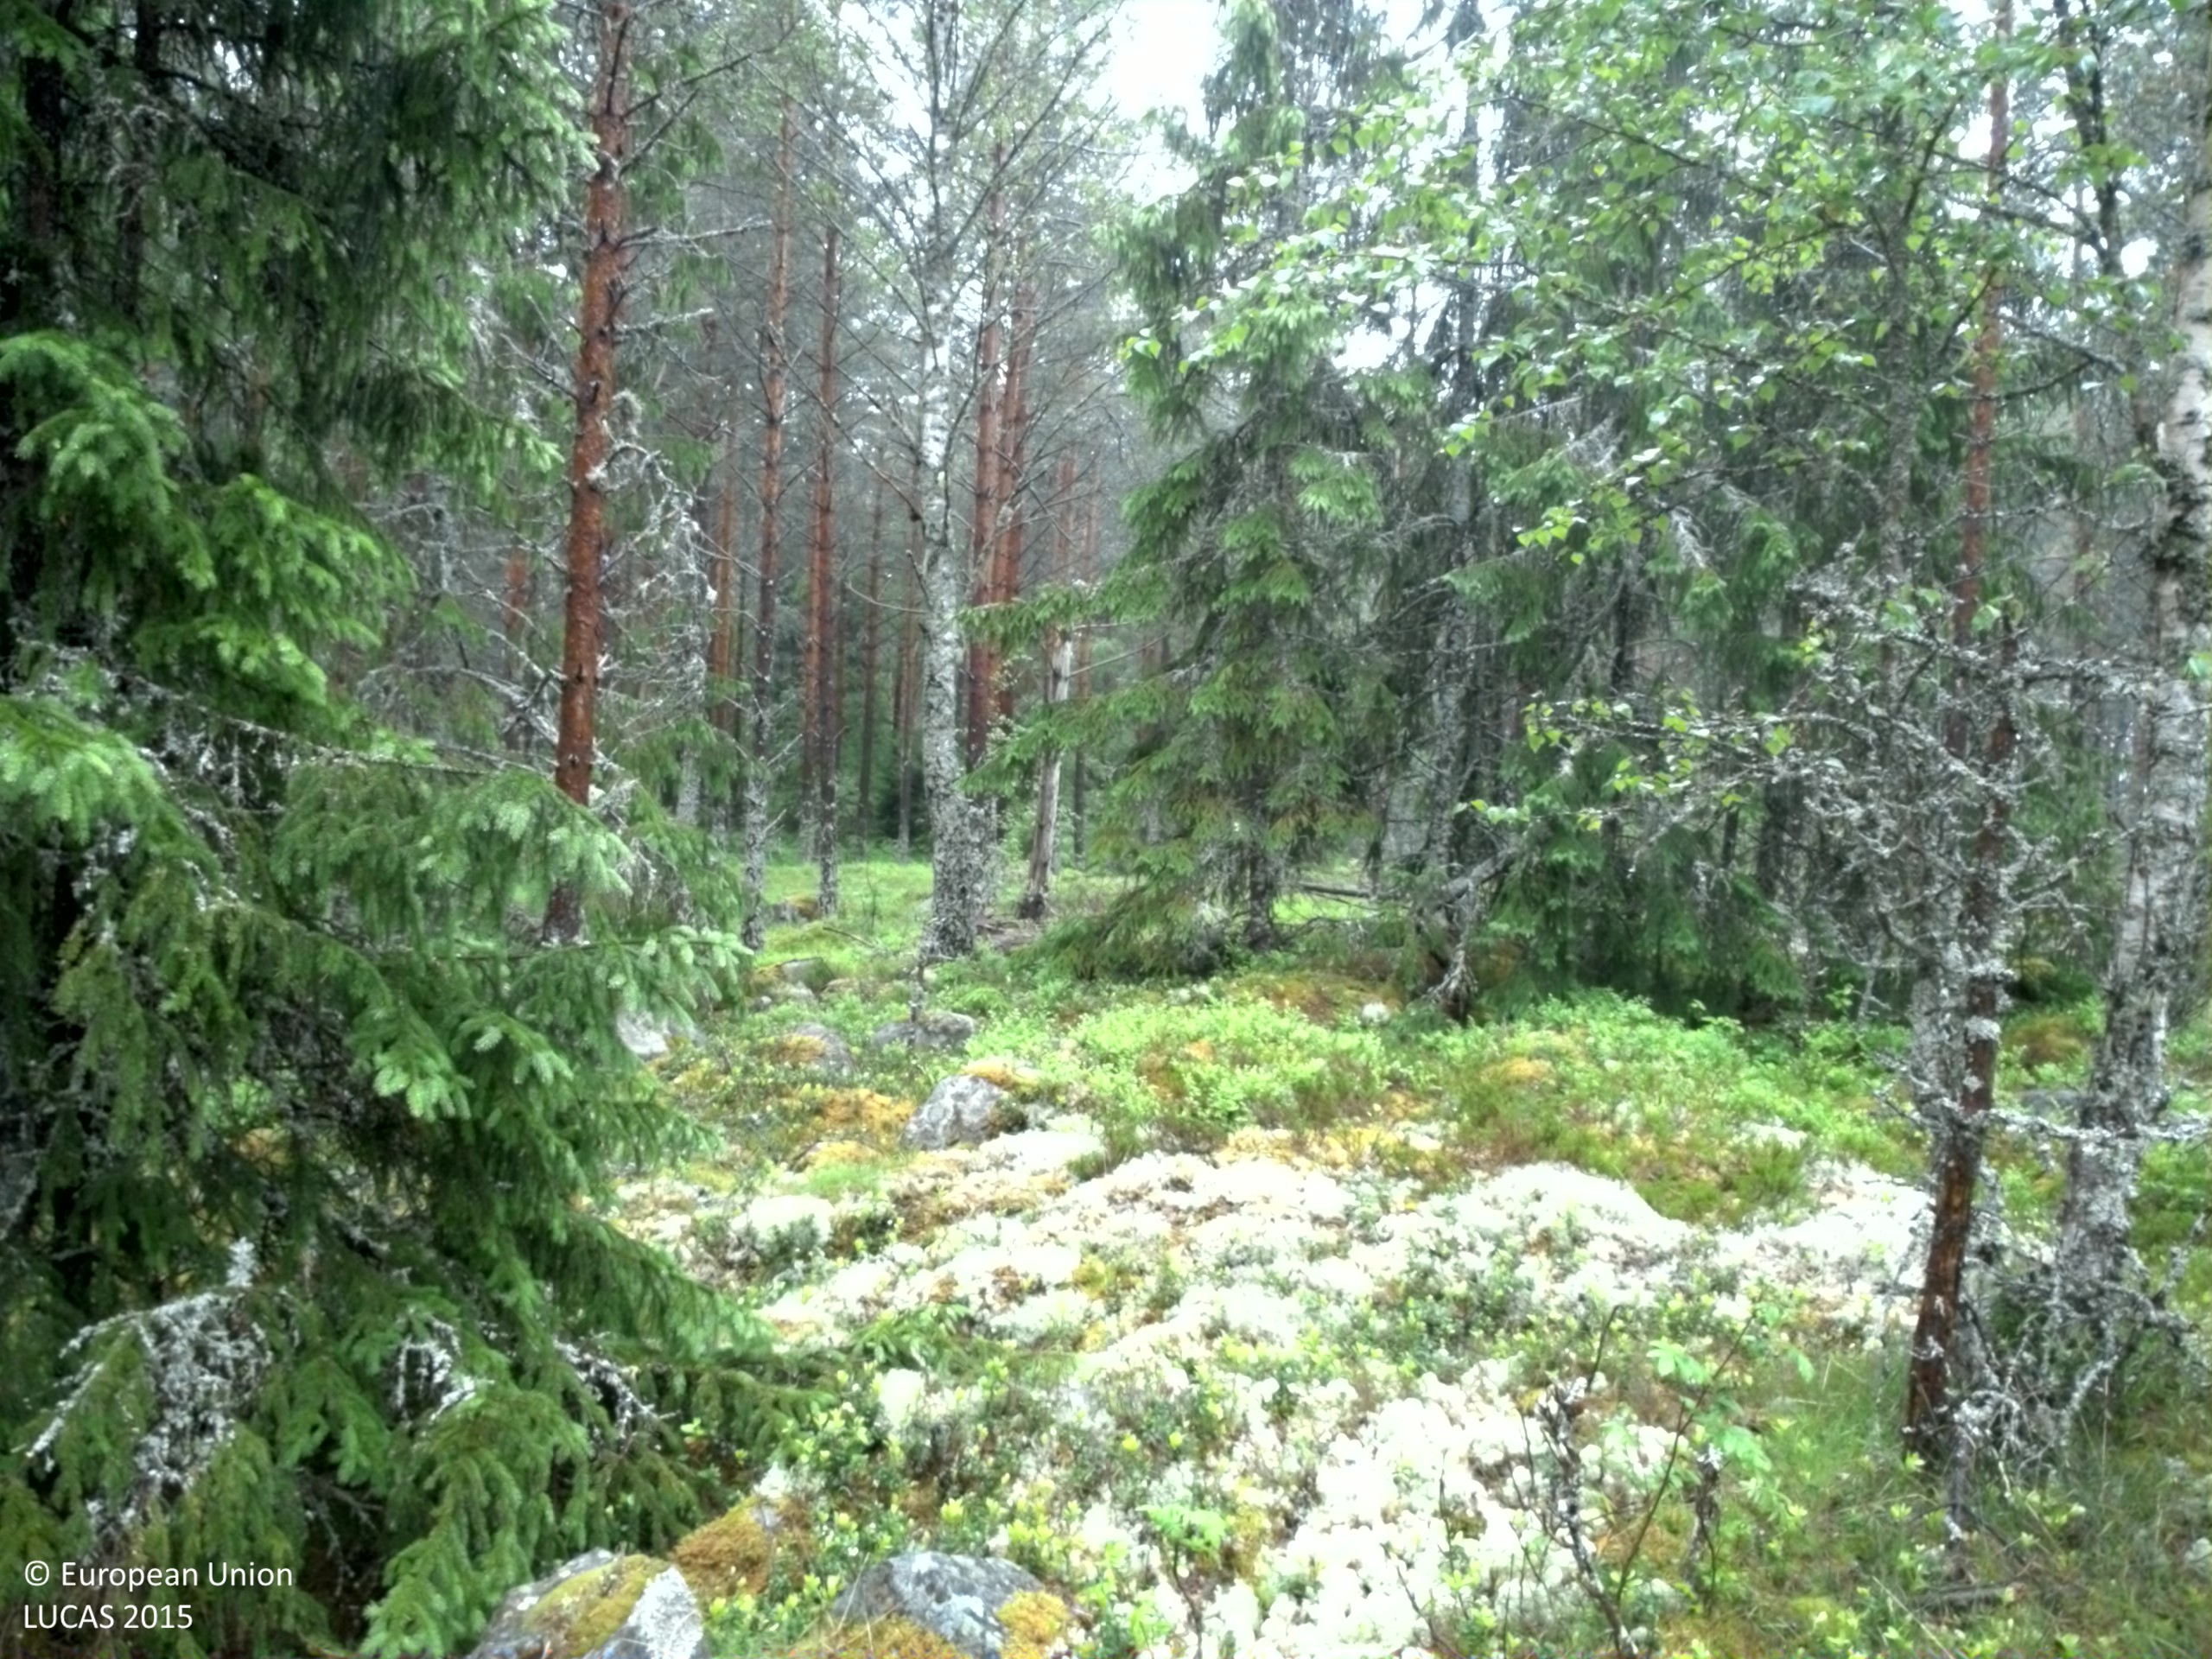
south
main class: Woodland
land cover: Pine dominated coniferous woodland
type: boreal forest
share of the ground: 50 - 75 %
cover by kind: coniferous forest trees 60 %, lichens and mosses 20 %, broadleaved forest trees 5 %, shrubs 5 %, herbaceous plants 5 %, consolidated bare surface 5 %
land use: Forestry
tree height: > 5 m
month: June
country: SE
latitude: 60.3643
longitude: 18.0978
